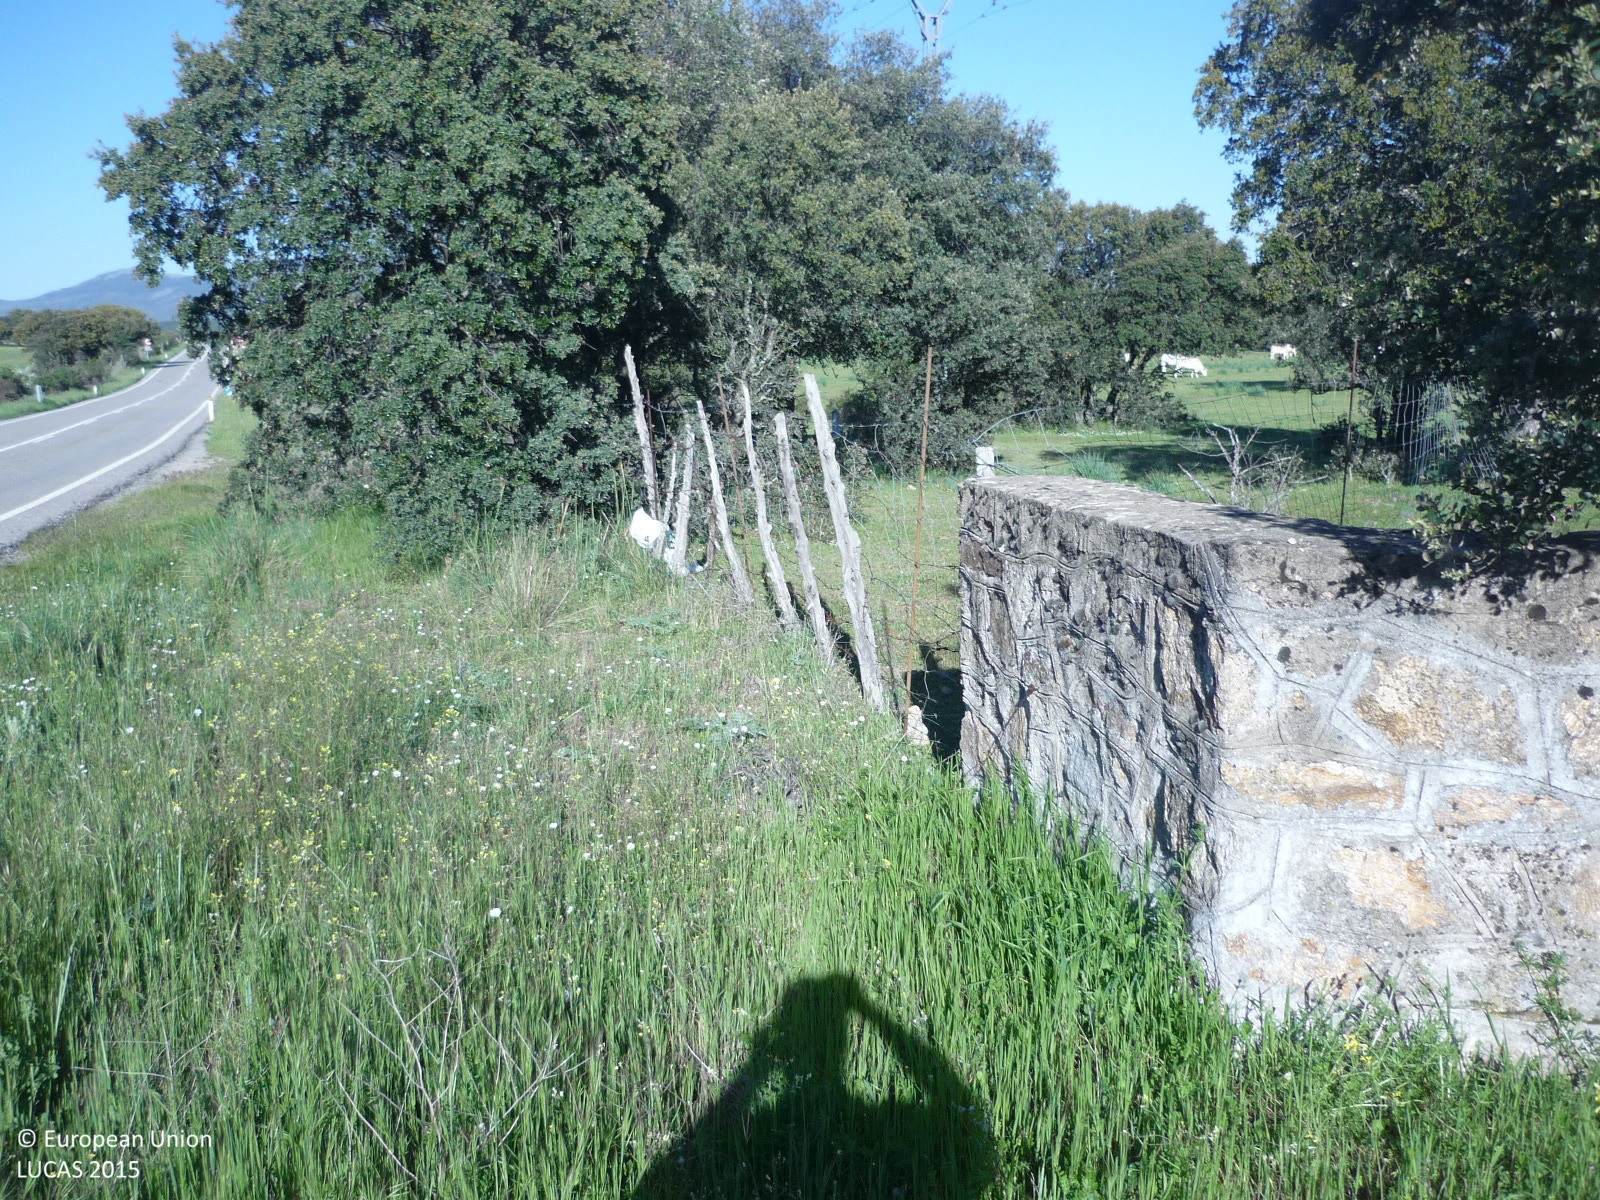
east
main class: Woodland
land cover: Broadleaved woodland
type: broadleaved evergreen forest
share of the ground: > 75 %
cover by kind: broadleaved forest trees 85 %, shrubs 10 %, herbaceous plants 5 %
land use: Forestry
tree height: > 5 m
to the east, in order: Broadleaved woodland; Tracks; Broadleaved woodland
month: May
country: ES
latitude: 40.9957
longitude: -3.6315
